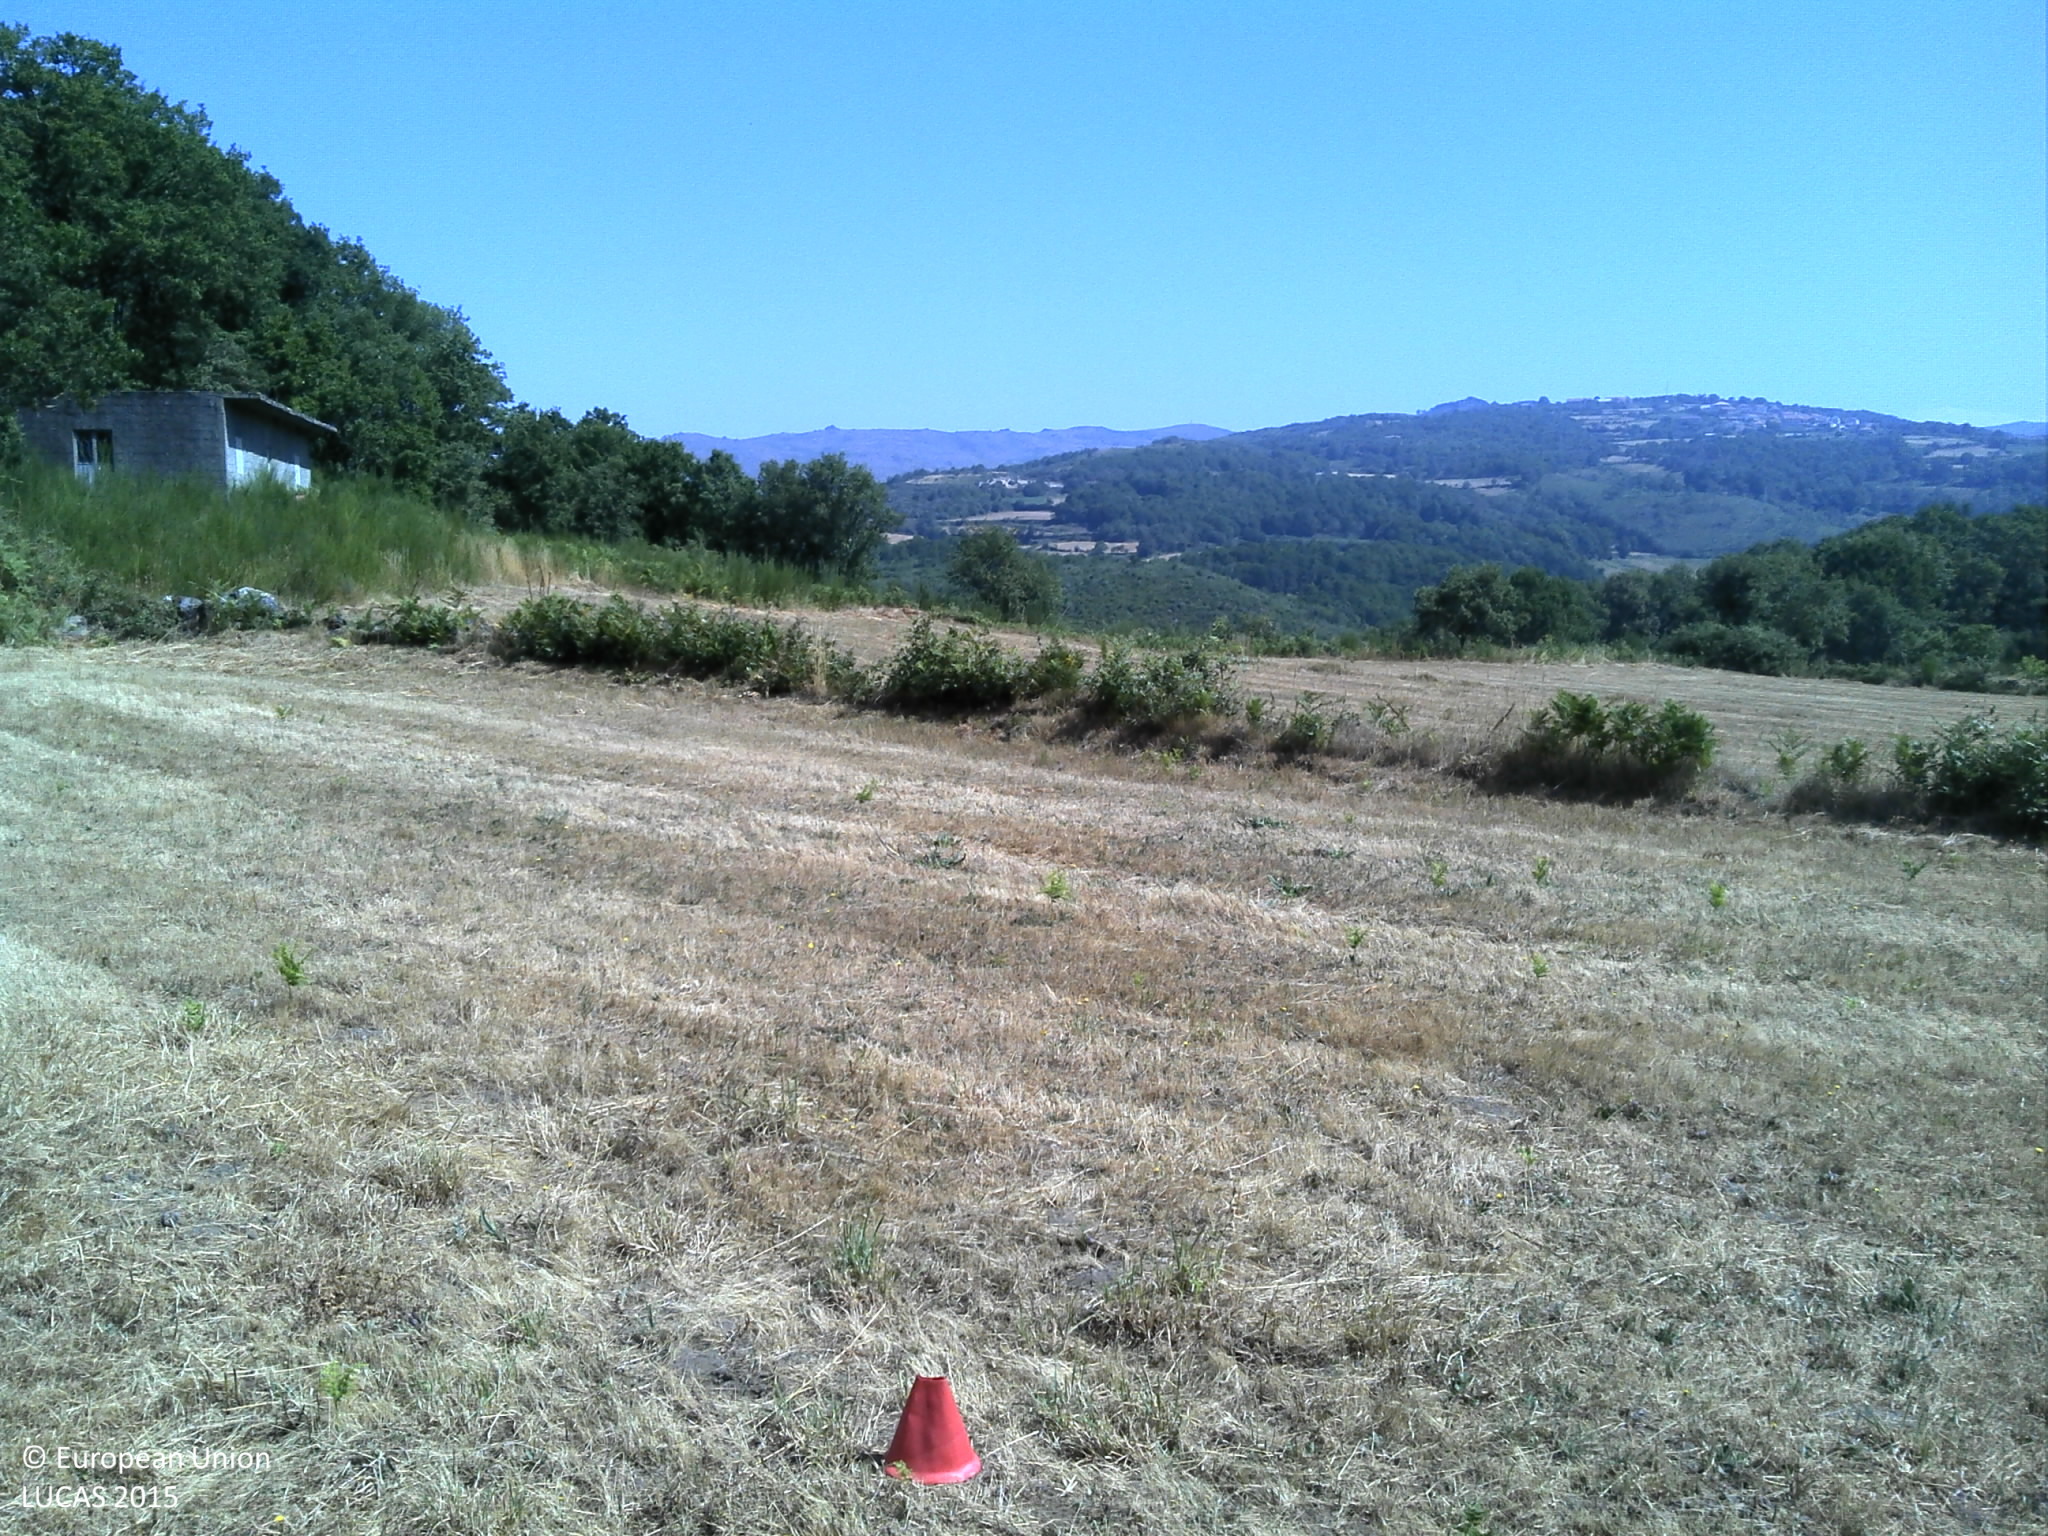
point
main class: Grassland
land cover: Grassland without tree/shrub cover
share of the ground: > 75 %
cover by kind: herbaceous plants 90 %, unconsolidated bare surface 10 %
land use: Agriculture (excluding fallow land and kitchen gardens)
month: July
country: PT
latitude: 41.7755
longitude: -7.9367
